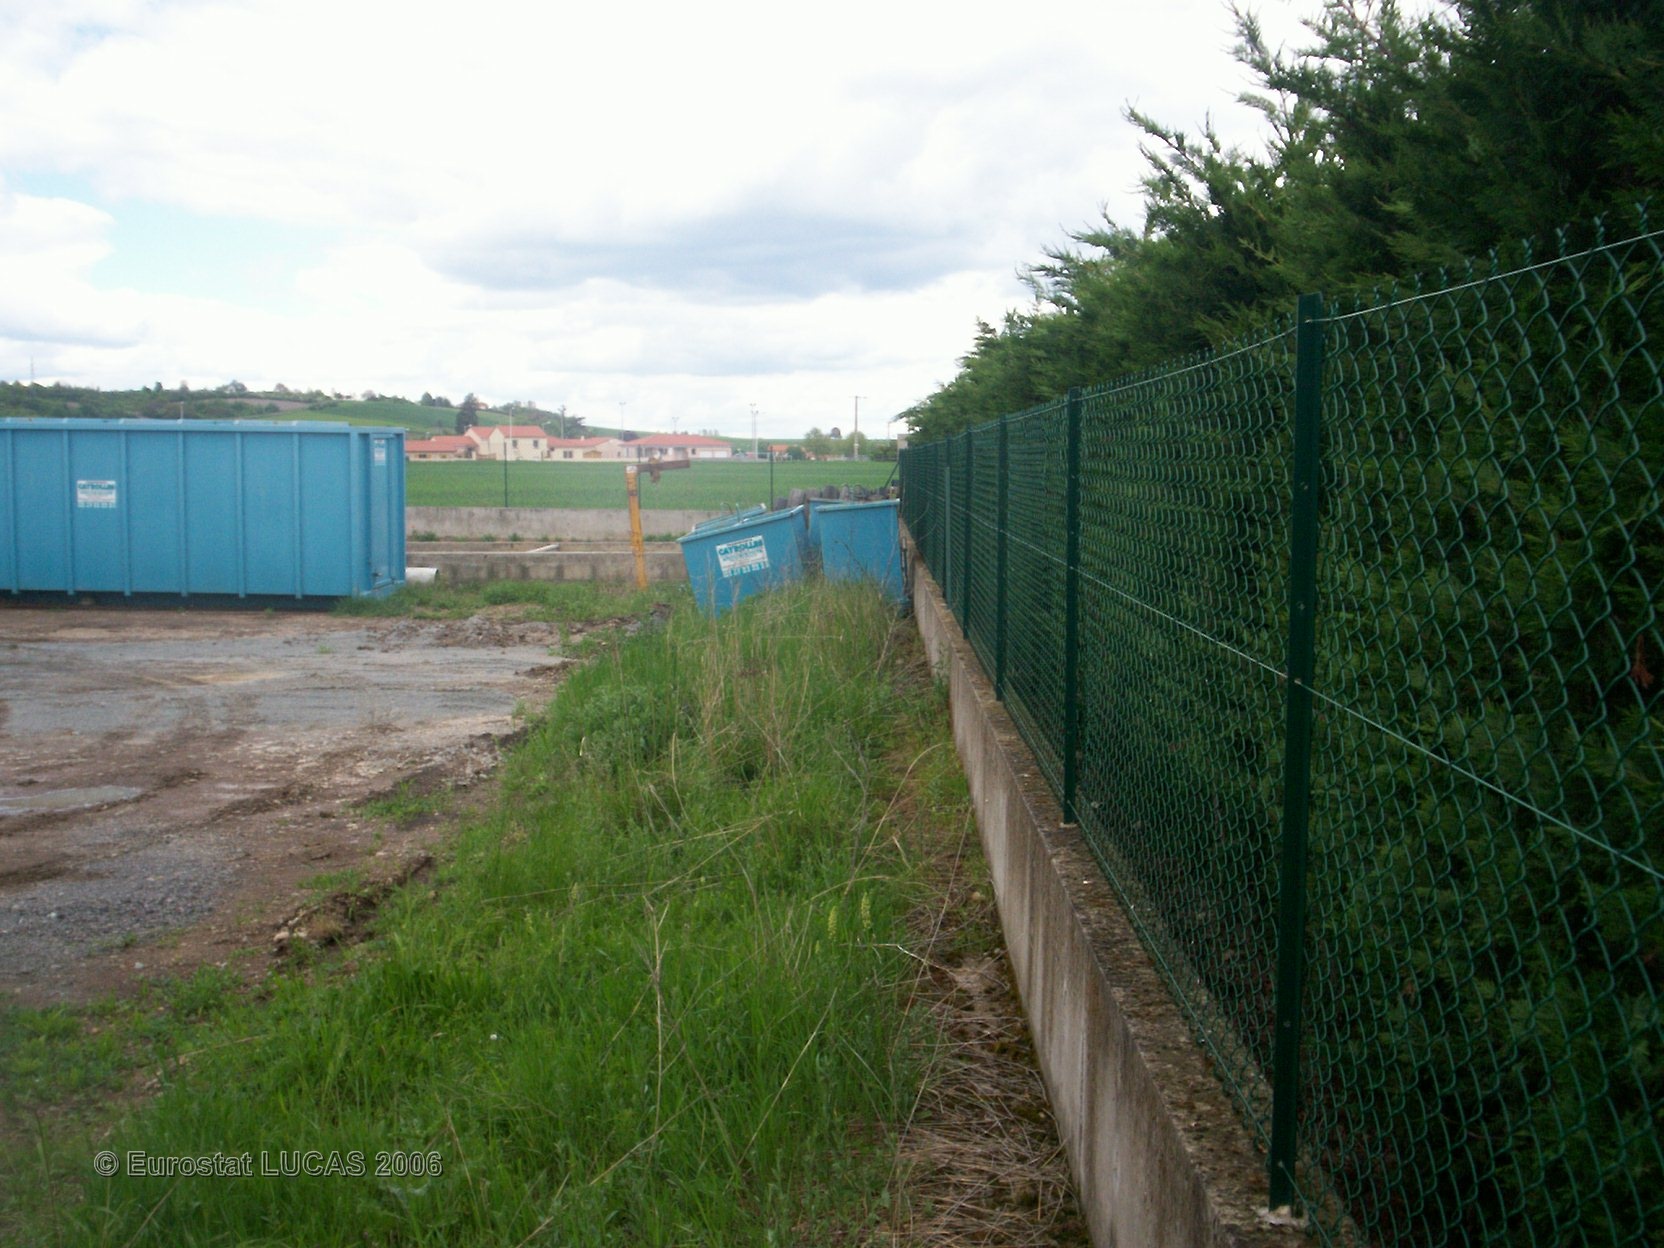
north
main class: Grassland
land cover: Grassland without tree/shrub cover
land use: Residential
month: May
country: FR
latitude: 45.8317
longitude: 3.2673
